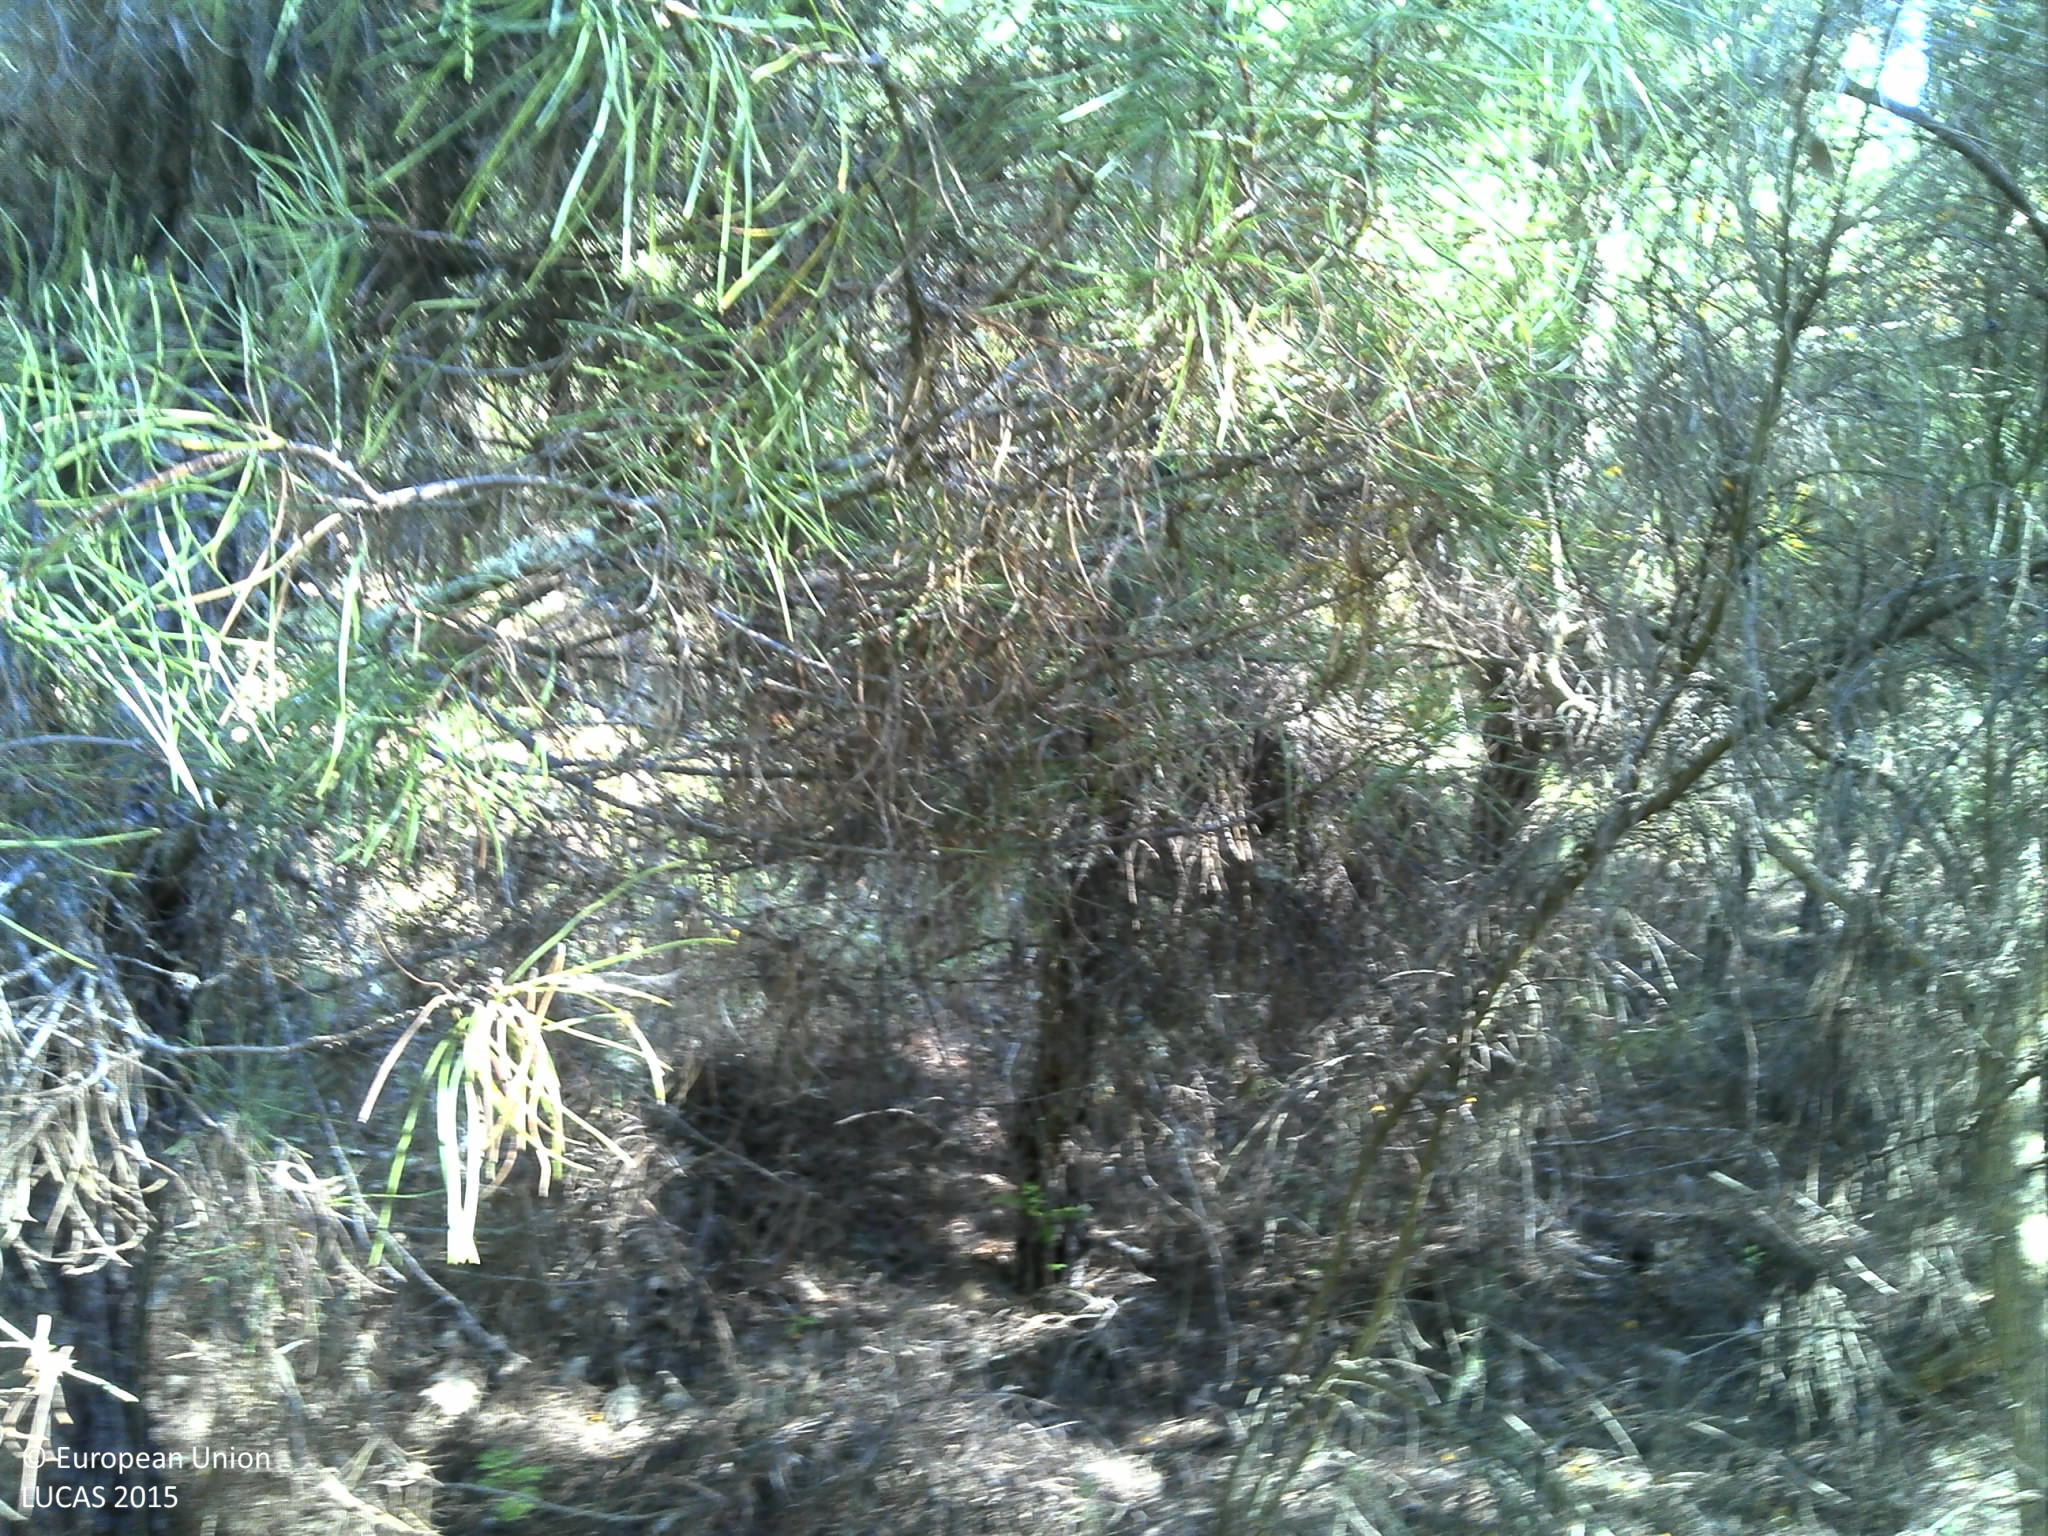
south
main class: Woodland
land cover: Pine dominated mixed woodland
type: coniferous forest of the mediterranean region
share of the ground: 25 - 50 %
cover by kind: shrubs 45 %, coniferous forest trees 25 %, unconsolidated bare surface 20 %, broadleaved forest trees 10 %
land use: Forestry
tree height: > 5 m
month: May
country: PT
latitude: 41.6251
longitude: -6.3650
